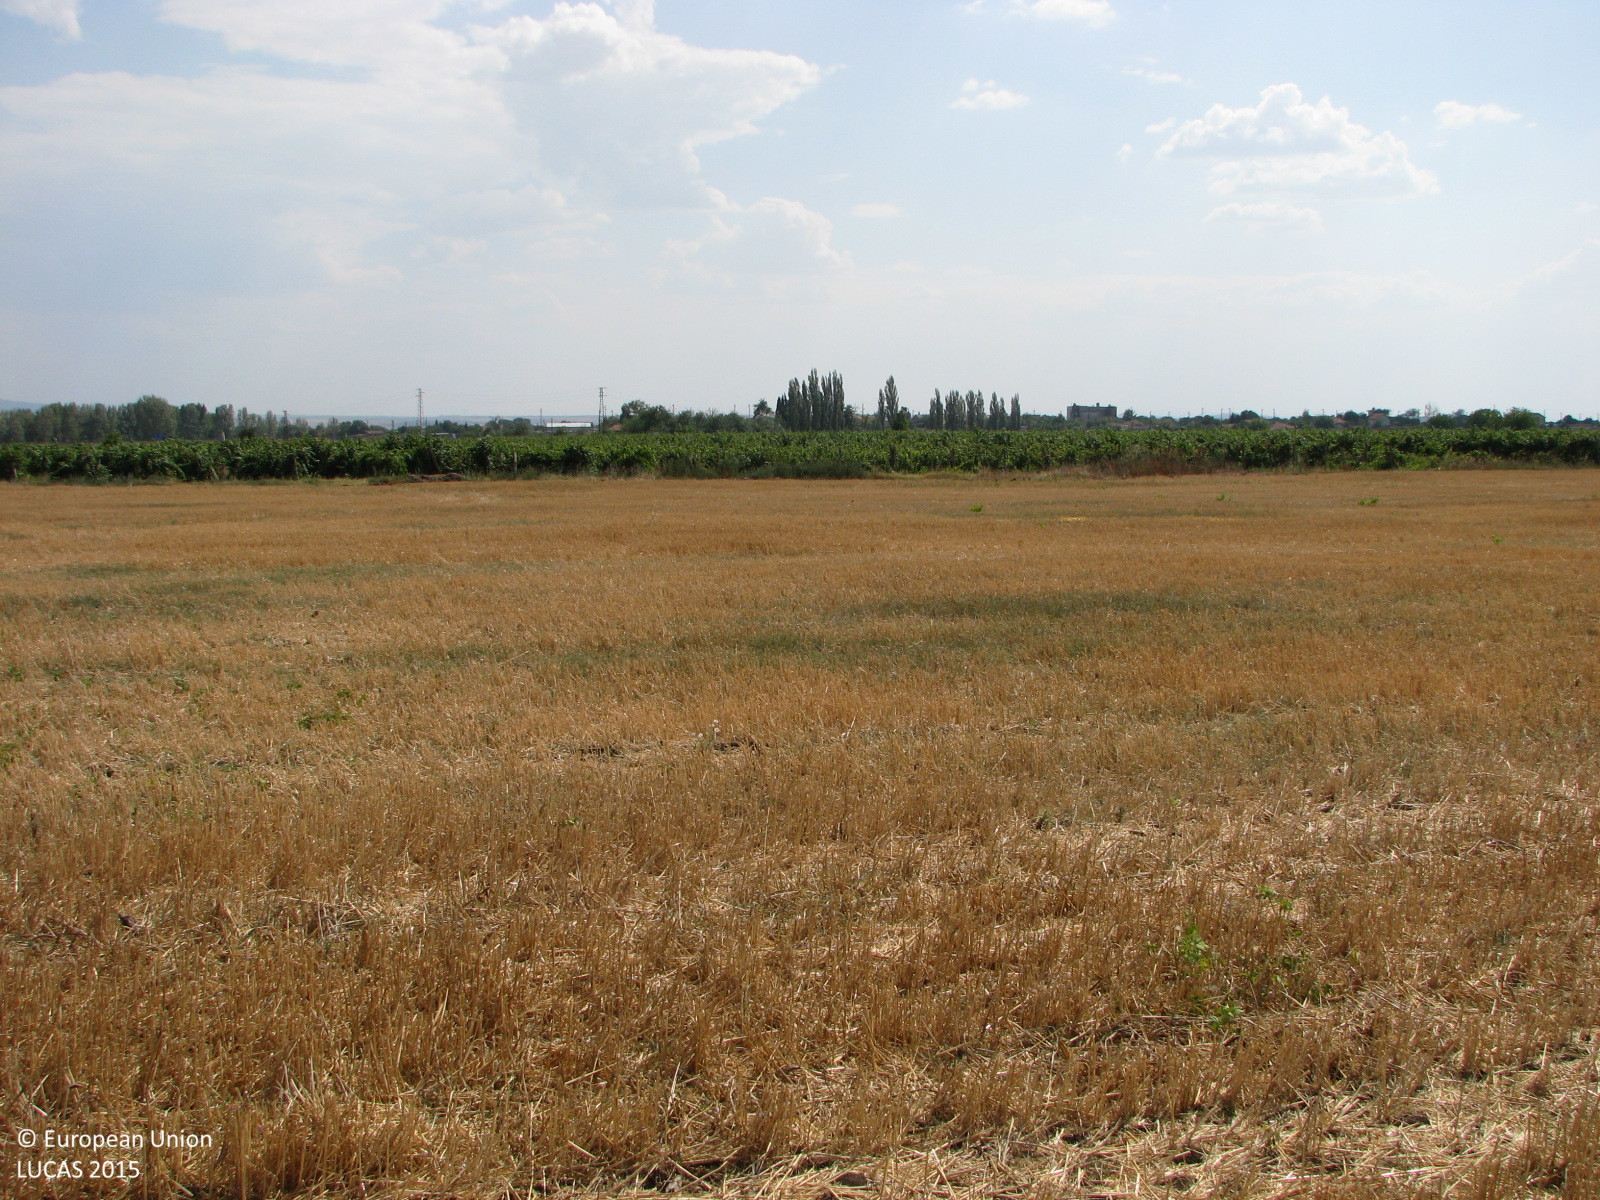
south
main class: Cropland
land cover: Common wheat
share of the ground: 50 - 75 %
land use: Agriculture (excluding fallow land and kitchen gardens)
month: August
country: BG
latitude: 42.5959
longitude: 26.6098
